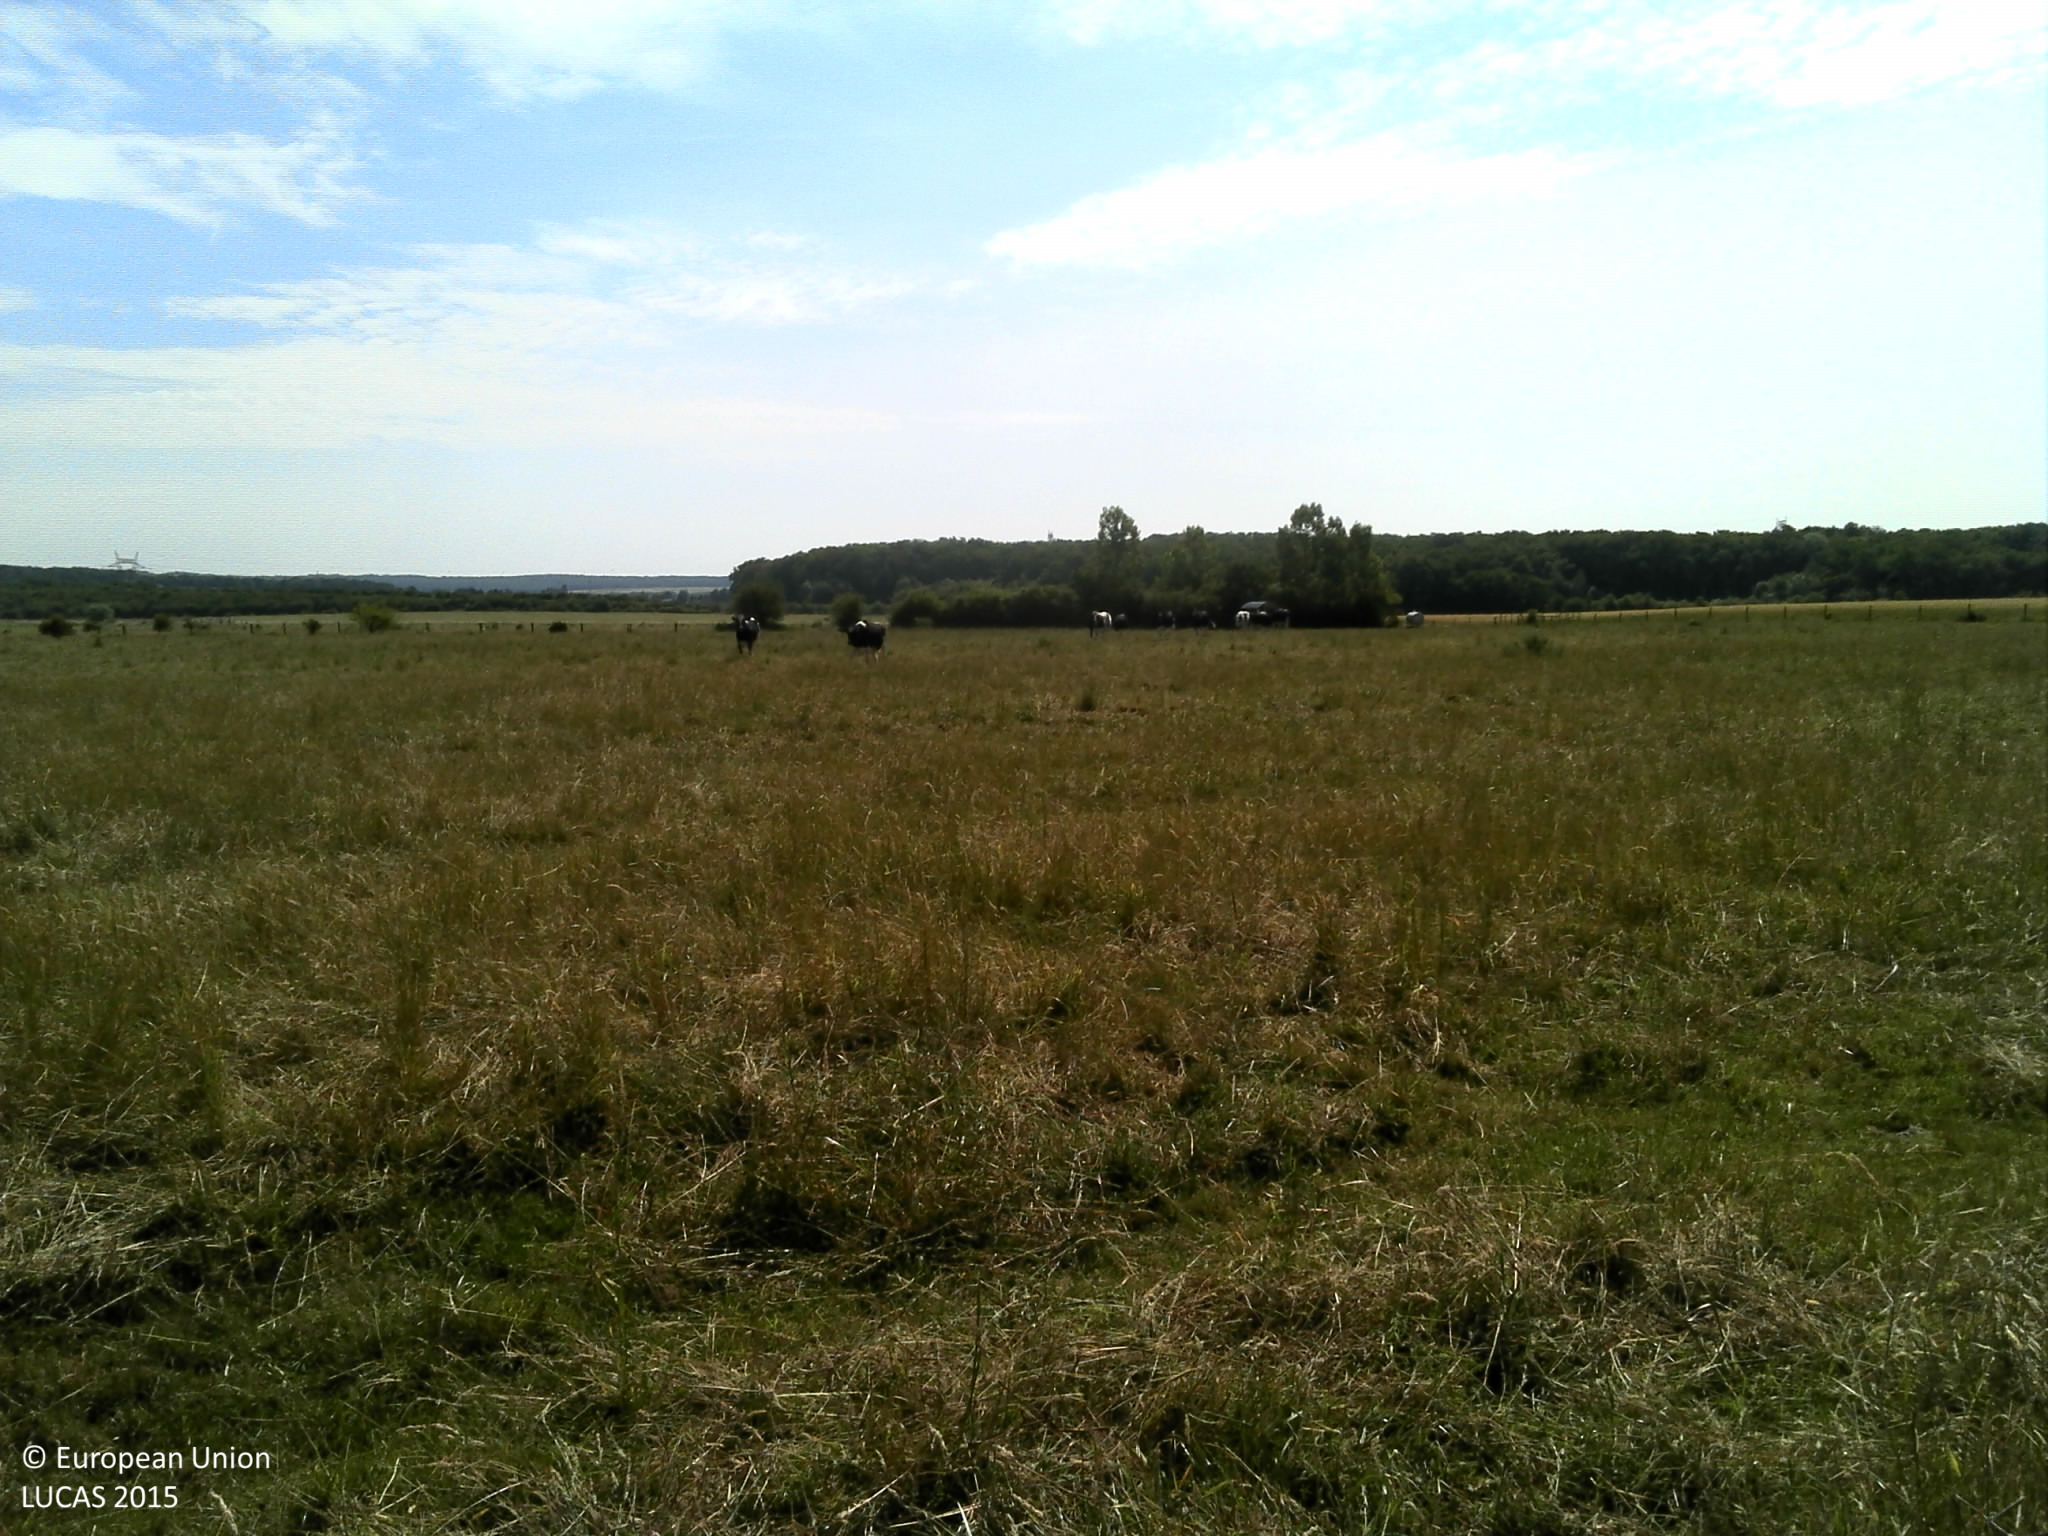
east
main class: Grassland
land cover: Grassland without tree/shrub cover
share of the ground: > 75 %
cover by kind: herbaceous plants 100 %
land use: Agriculture (excluding fallow land and kitchen gardens)
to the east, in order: Grassland without tree/shrub cover; Fences; Broadleaved woodland; Grassland without tree/shrub cover
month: June
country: FR
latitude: 49.3473
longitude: 6.2142
